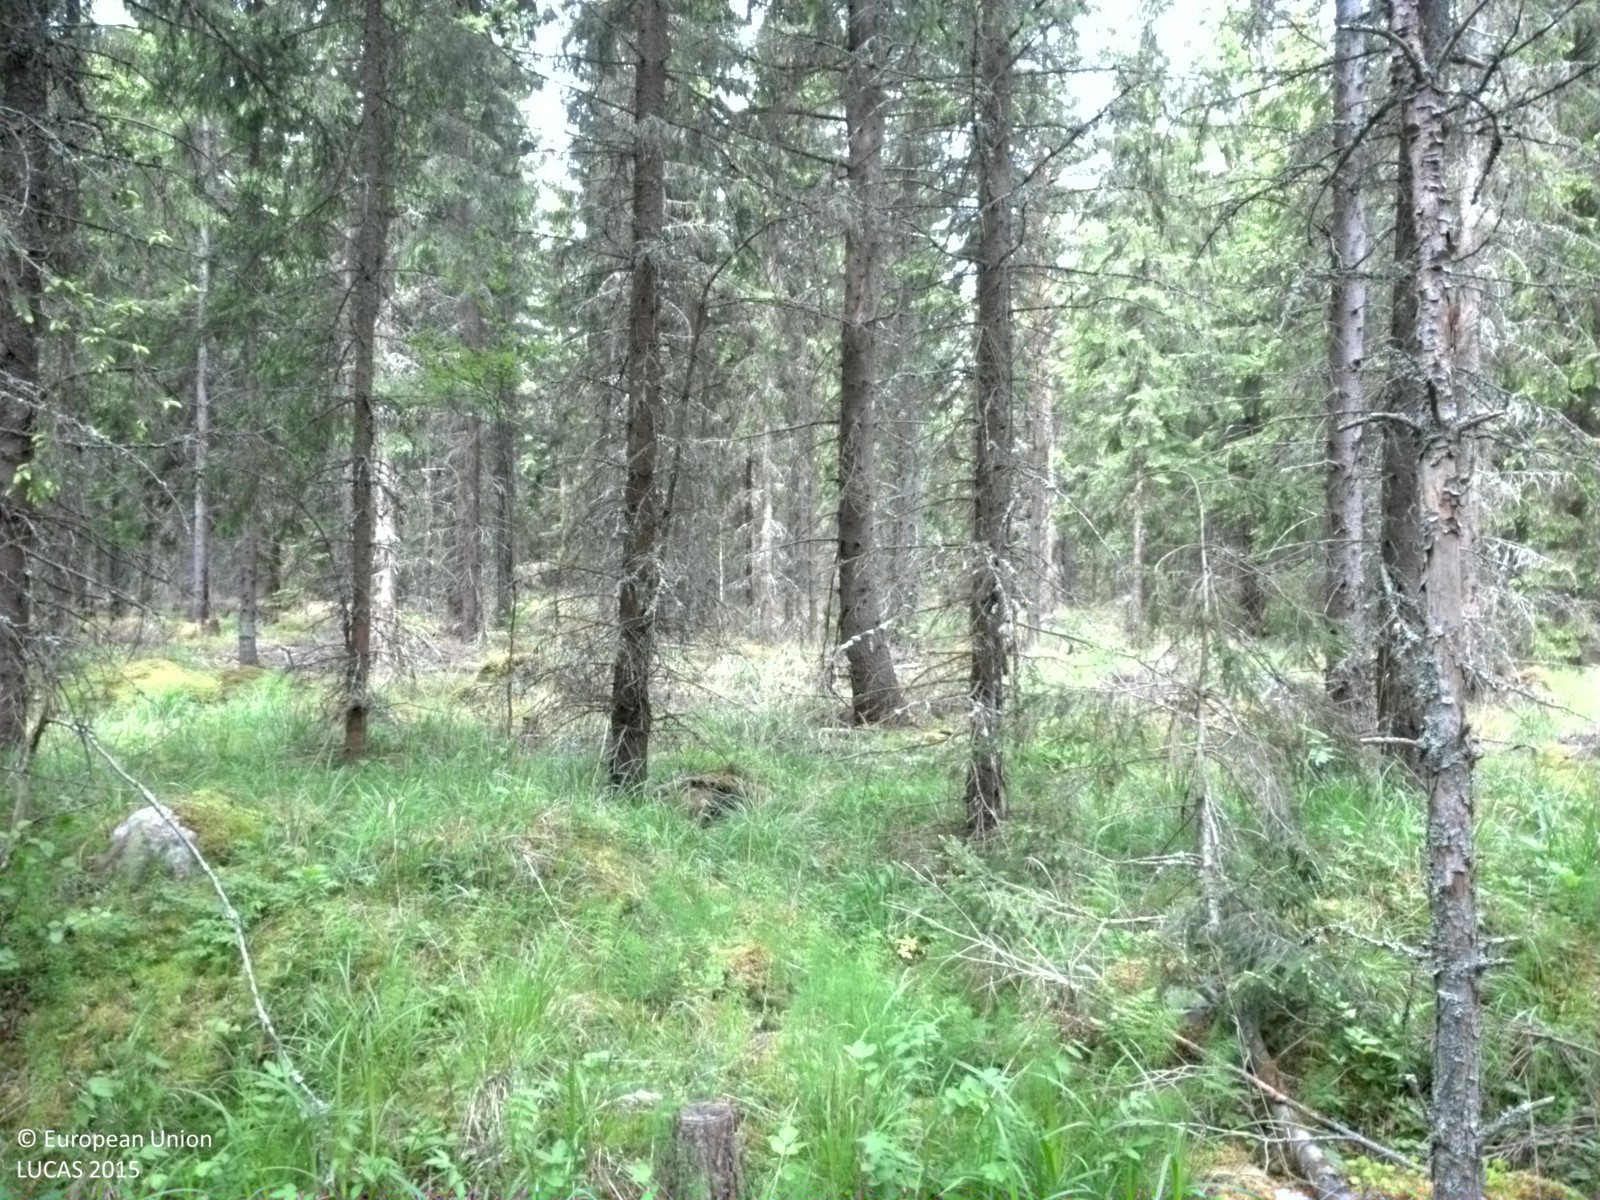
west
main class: Woodland
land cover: Spruce dominated coniferous woodland
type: boreal forest
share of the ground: 50 - 75 %
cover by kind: coniferous forest trees 60 %, herbaceous plants 25 %, broadleaved forest trees 5 %, lichens and mosses 5 %
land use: Forestry
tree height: > 5 m
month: June
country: SE
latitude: 60.2769
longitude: 17.0242
